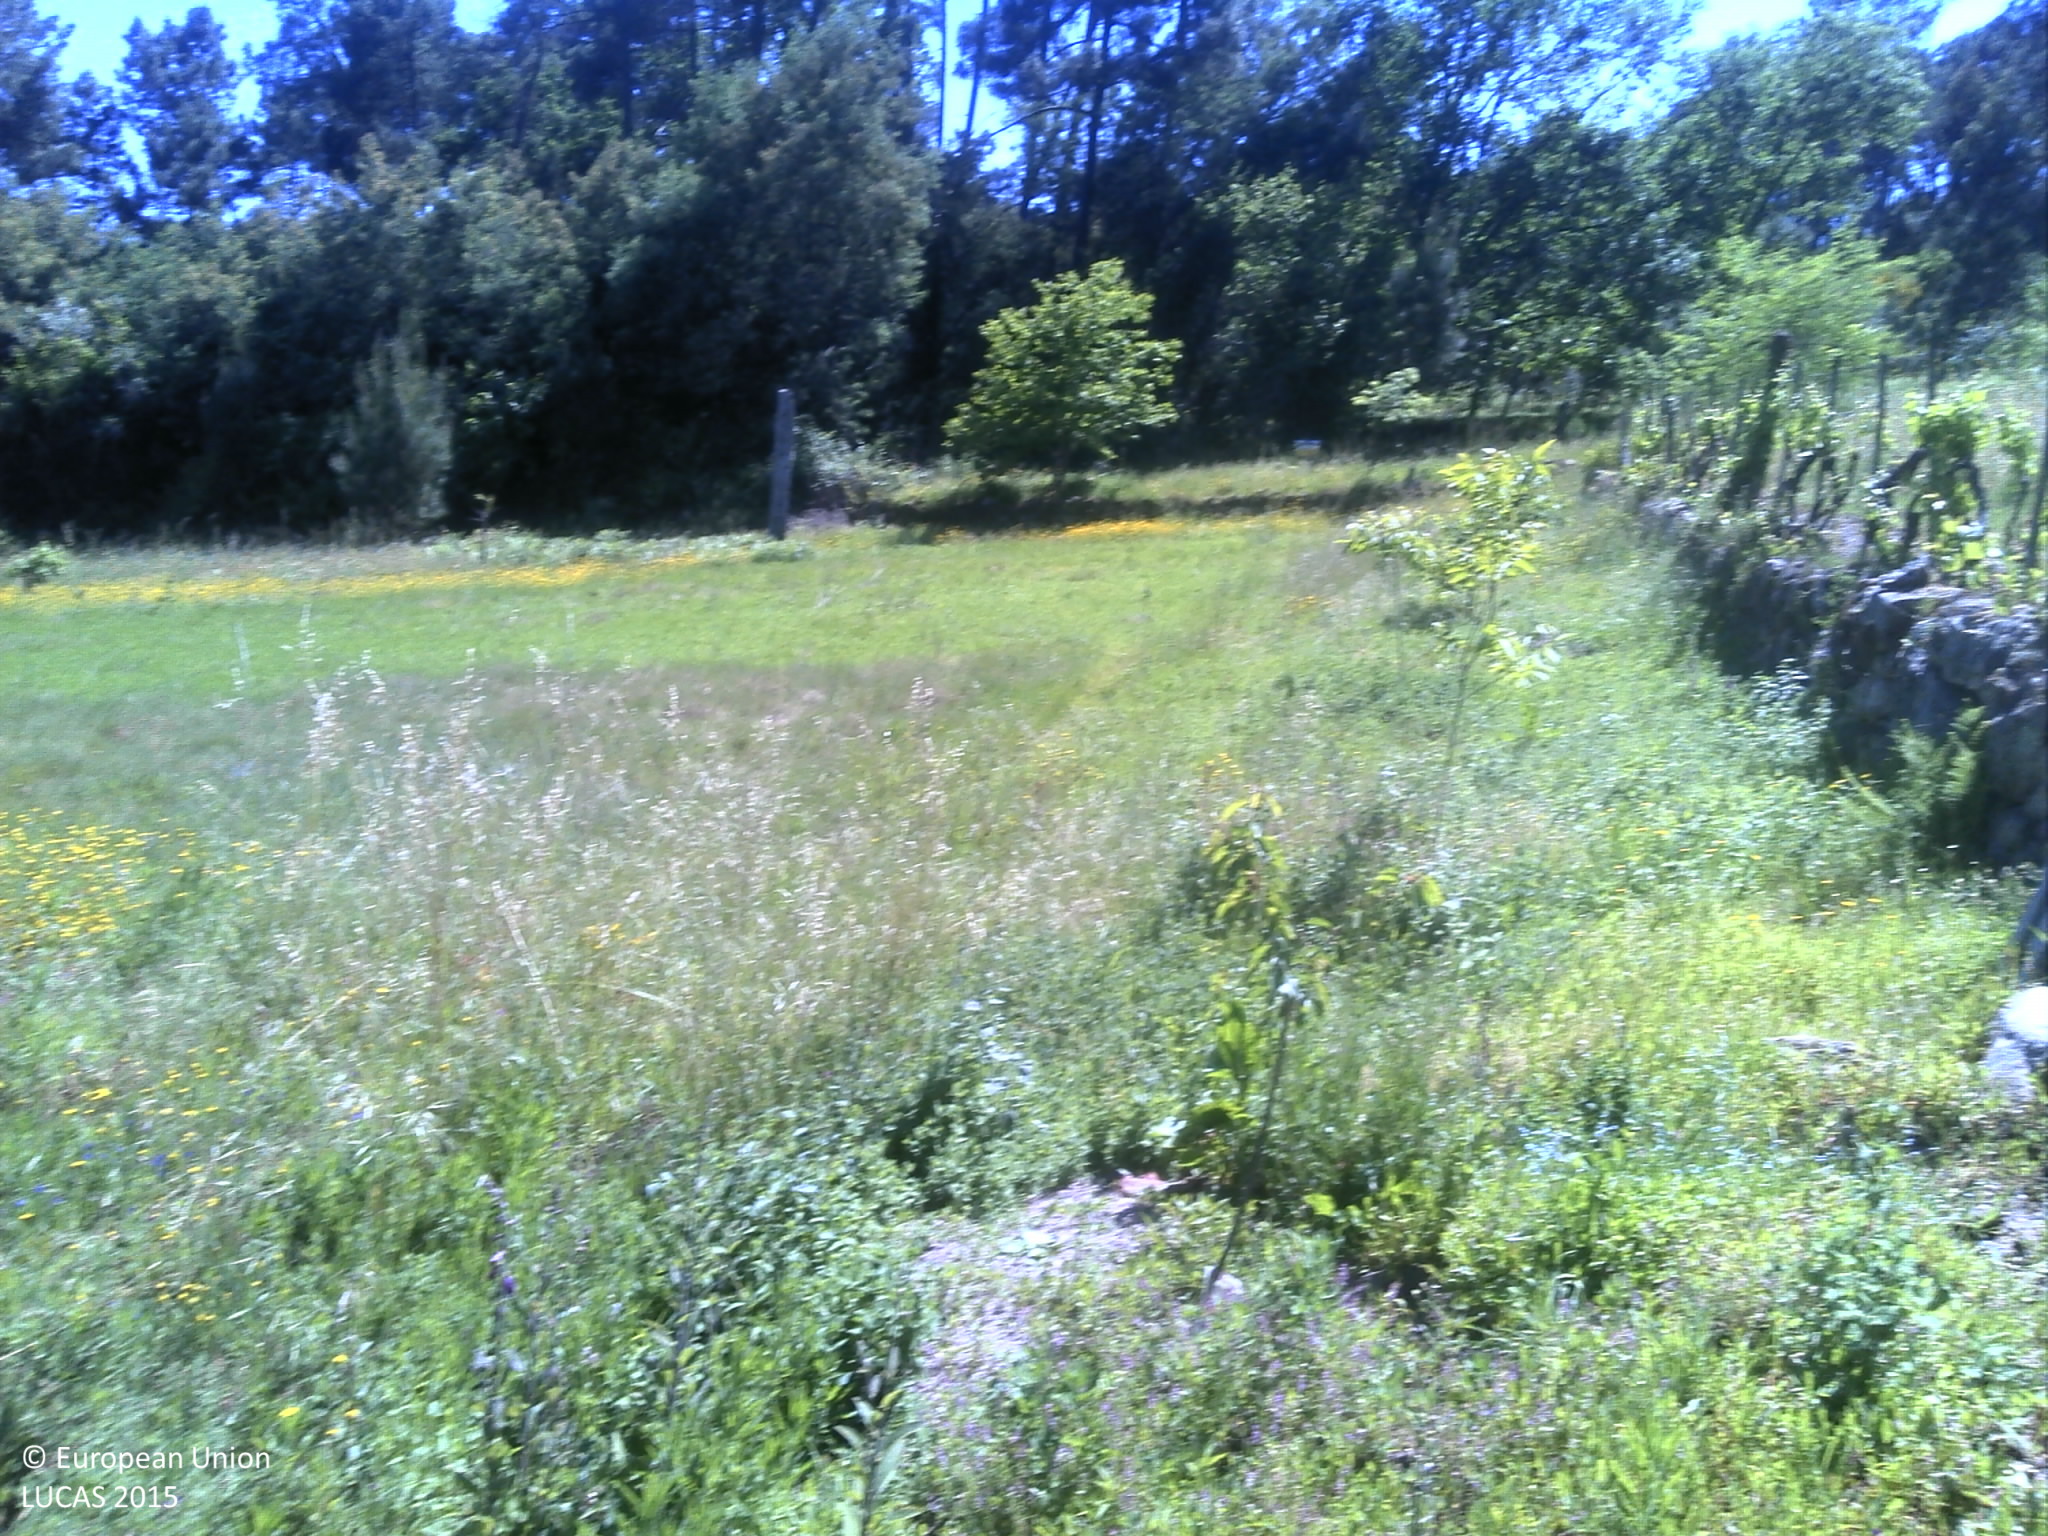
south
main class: Grassland
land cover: Grassland without tree/shrub cover
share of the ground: > 75 %
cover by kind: herbaceous plants 95 %, unconsolidated bare surface 5 %
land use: Agriculture (excluding fallow land and kitchen gardens)
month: May
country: PT
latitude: 40.5547
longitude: -7.7497
